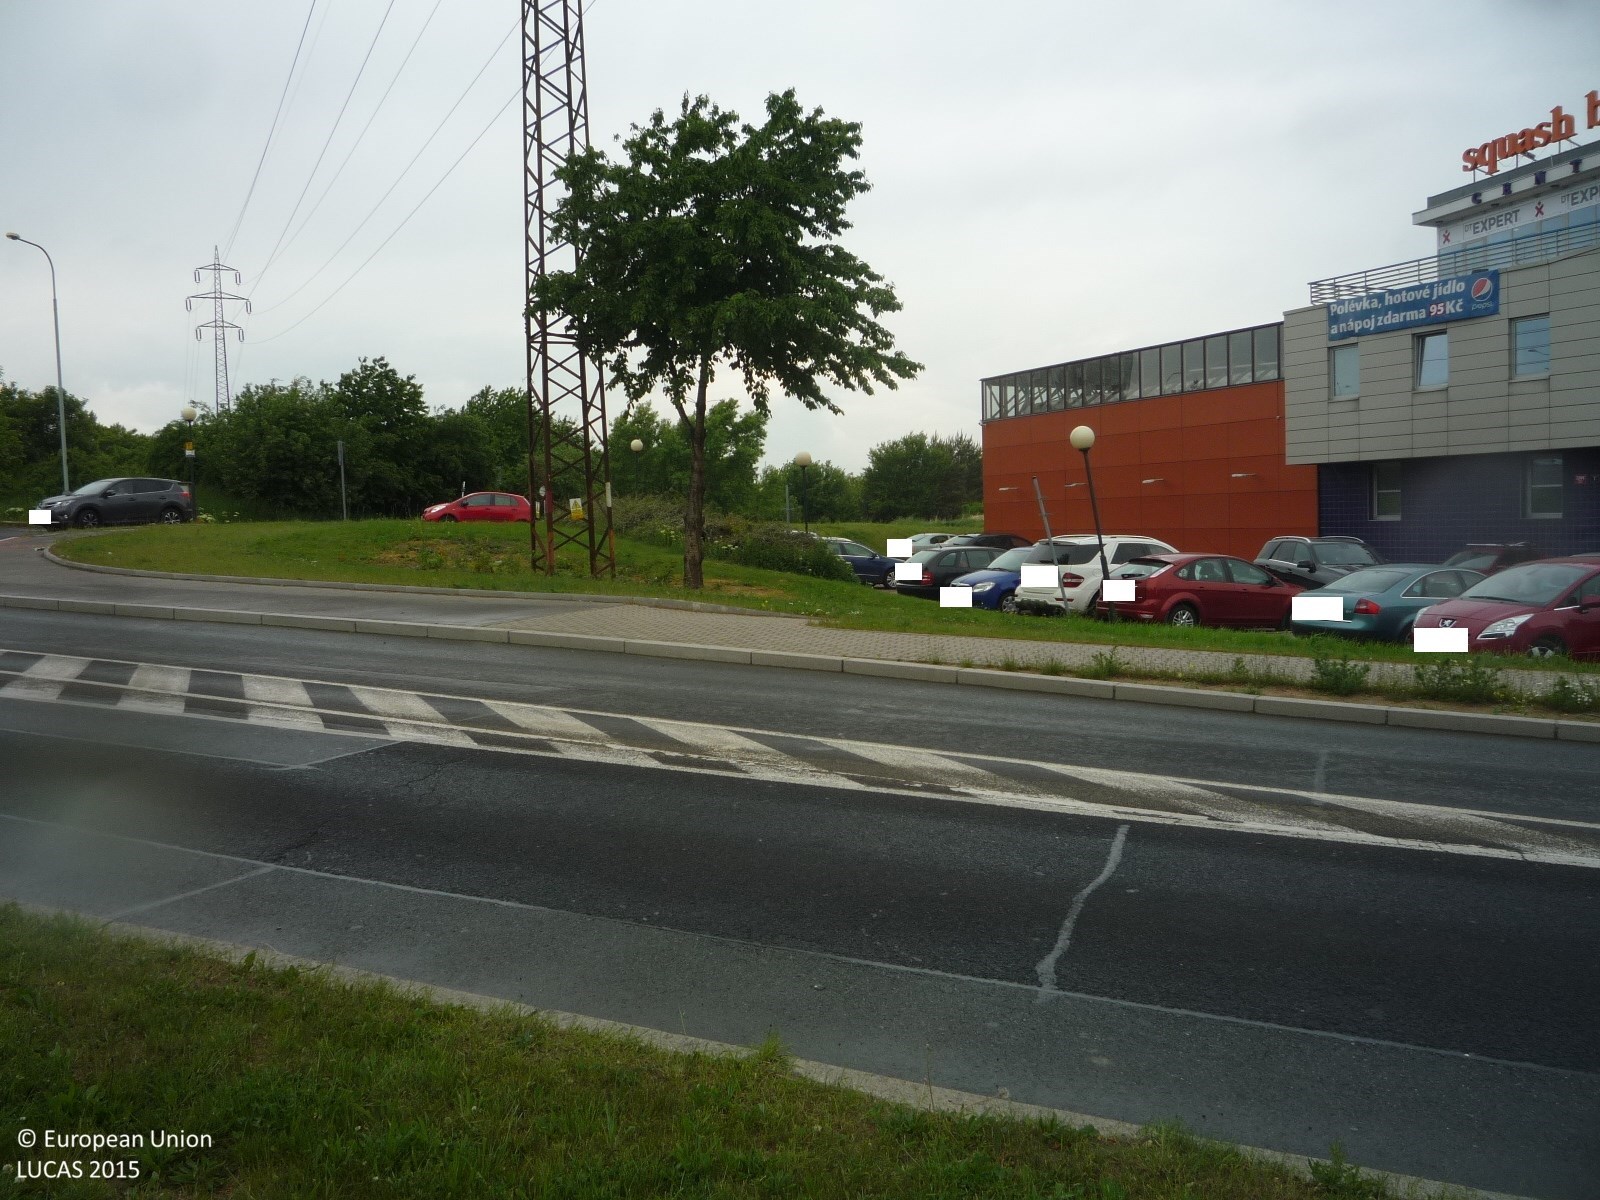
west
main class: Grassland
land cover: Grassland without tree/shrub cover
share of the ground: > 75 %
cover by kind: herbaceous plants 100 %
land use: Abandoned areas
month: May
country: CZ
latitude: 50.0410
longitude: 14.5118
